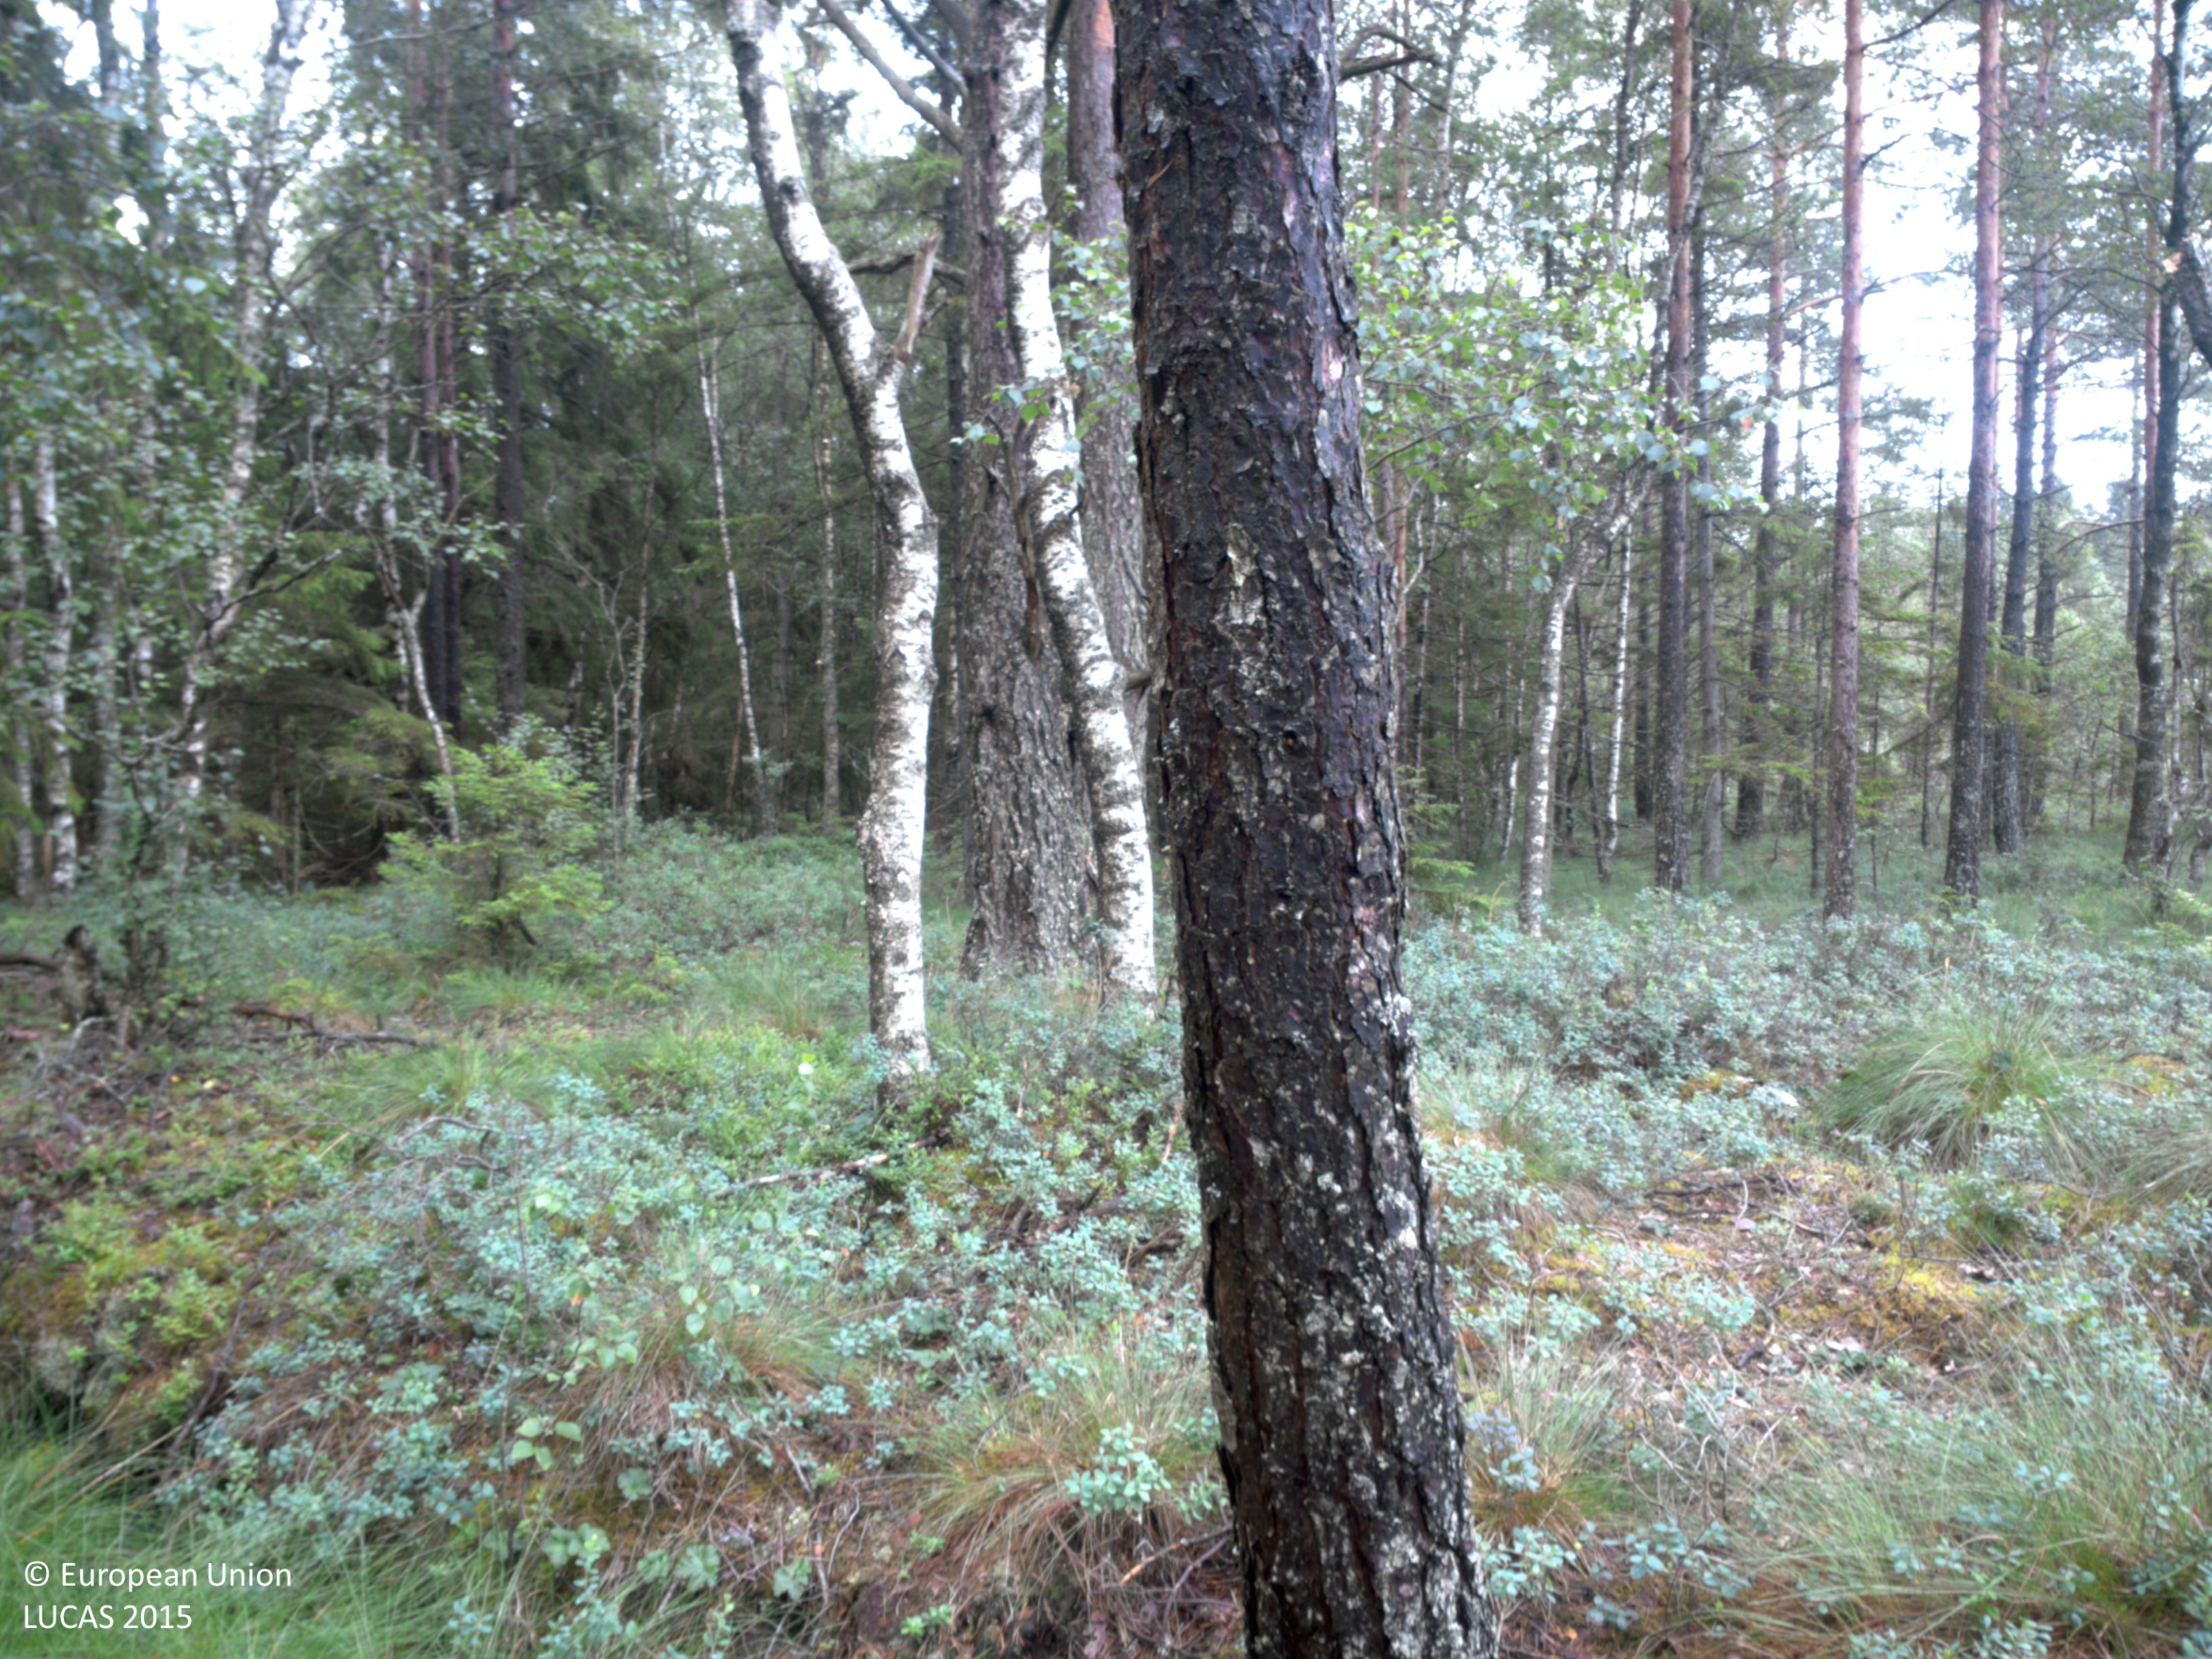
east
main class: Woodland
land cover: Pine dominated mixed woodland
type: boreal forest
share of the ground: 50 - 75 %
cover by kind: lichens and mosses 50 %, coniferous forest trees 30 %, broadleaved forest trees 20 %
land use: Semi-natural and natural areas not in use
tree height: < 5 m
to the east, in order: Pine dominated mixed woodland; Spruce dominated mixed woodland; Spruce dominated coniferous woodland; Spruce dominated mixed woodland; Ditches and canals; Grassland without tree/shrub cover
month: July
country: SE
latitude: 58.6183
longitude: 12.0101
